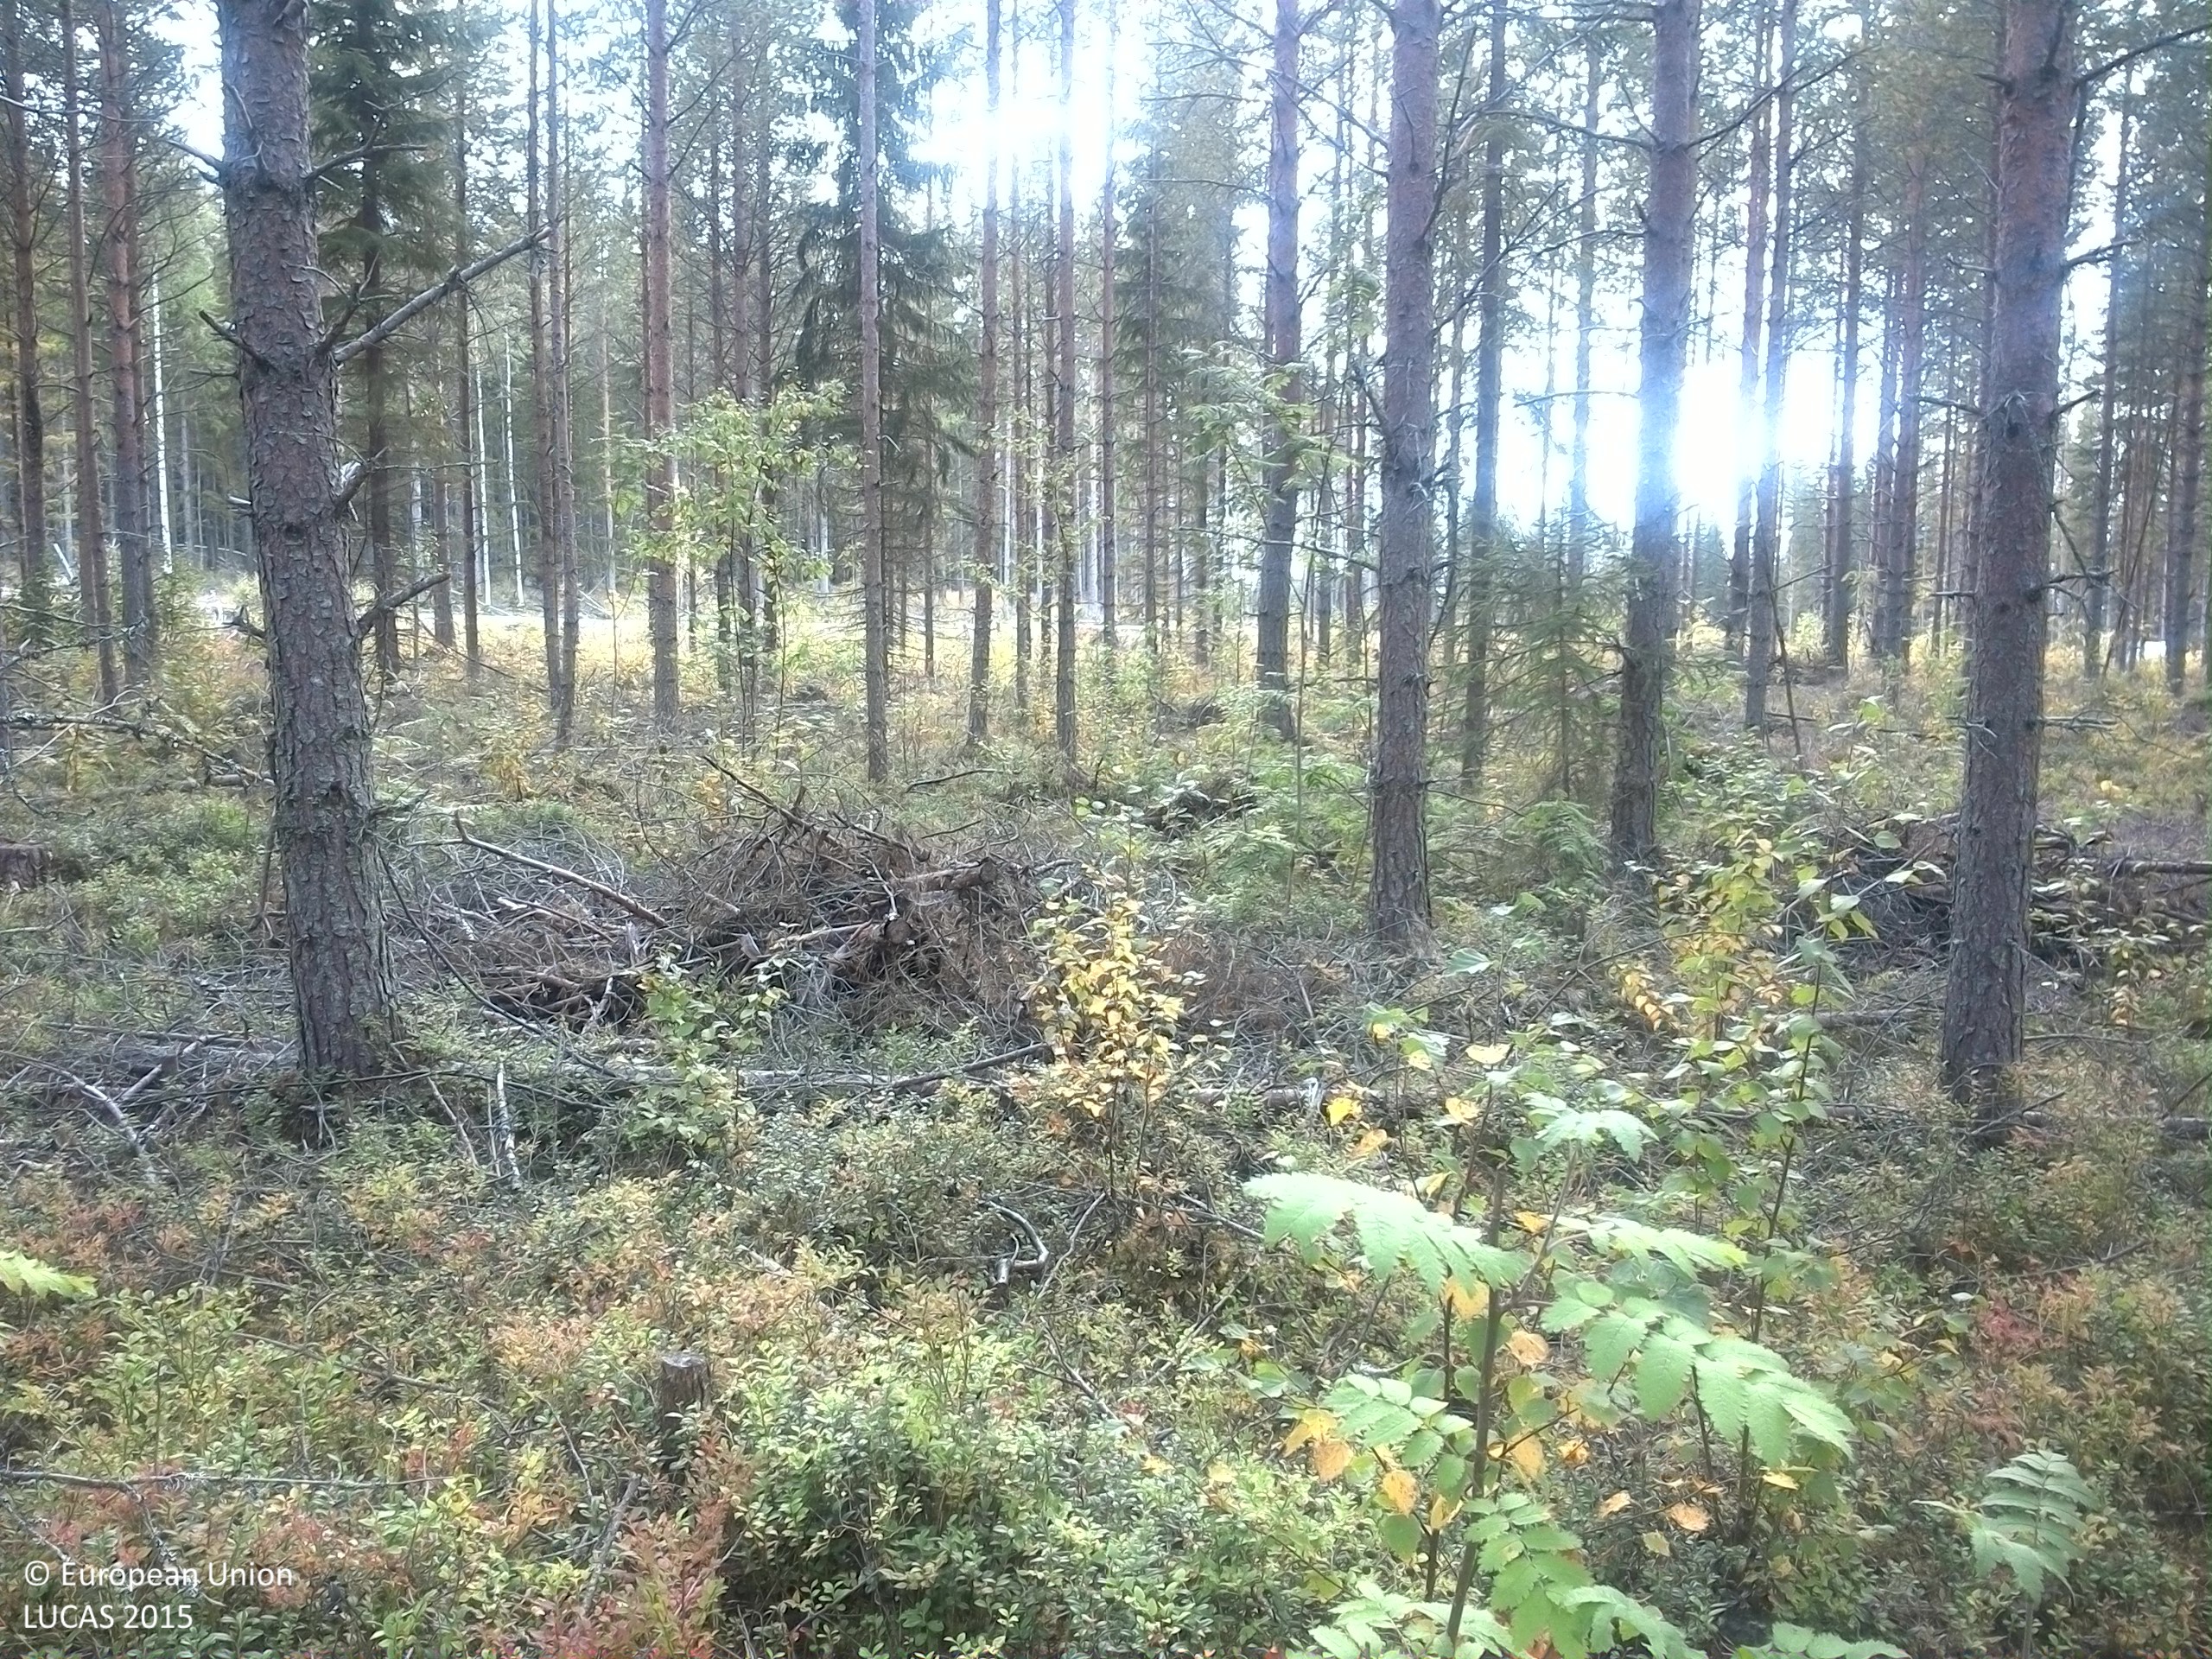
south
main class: Woodland
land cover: Pine dominated coniferous woodland
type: boreal forest
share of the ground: 50 - 75 %
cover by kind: coniferous forest trees 45 %, shrubs 35 %, lichens and mosses 10 %, broadleaved forest trees 5 %, herbaceous plants 5 %
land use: Forestry
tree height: > 5 m
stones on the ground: < 10 %
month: September
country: SE
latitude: 63.8336
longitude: 16.4150
